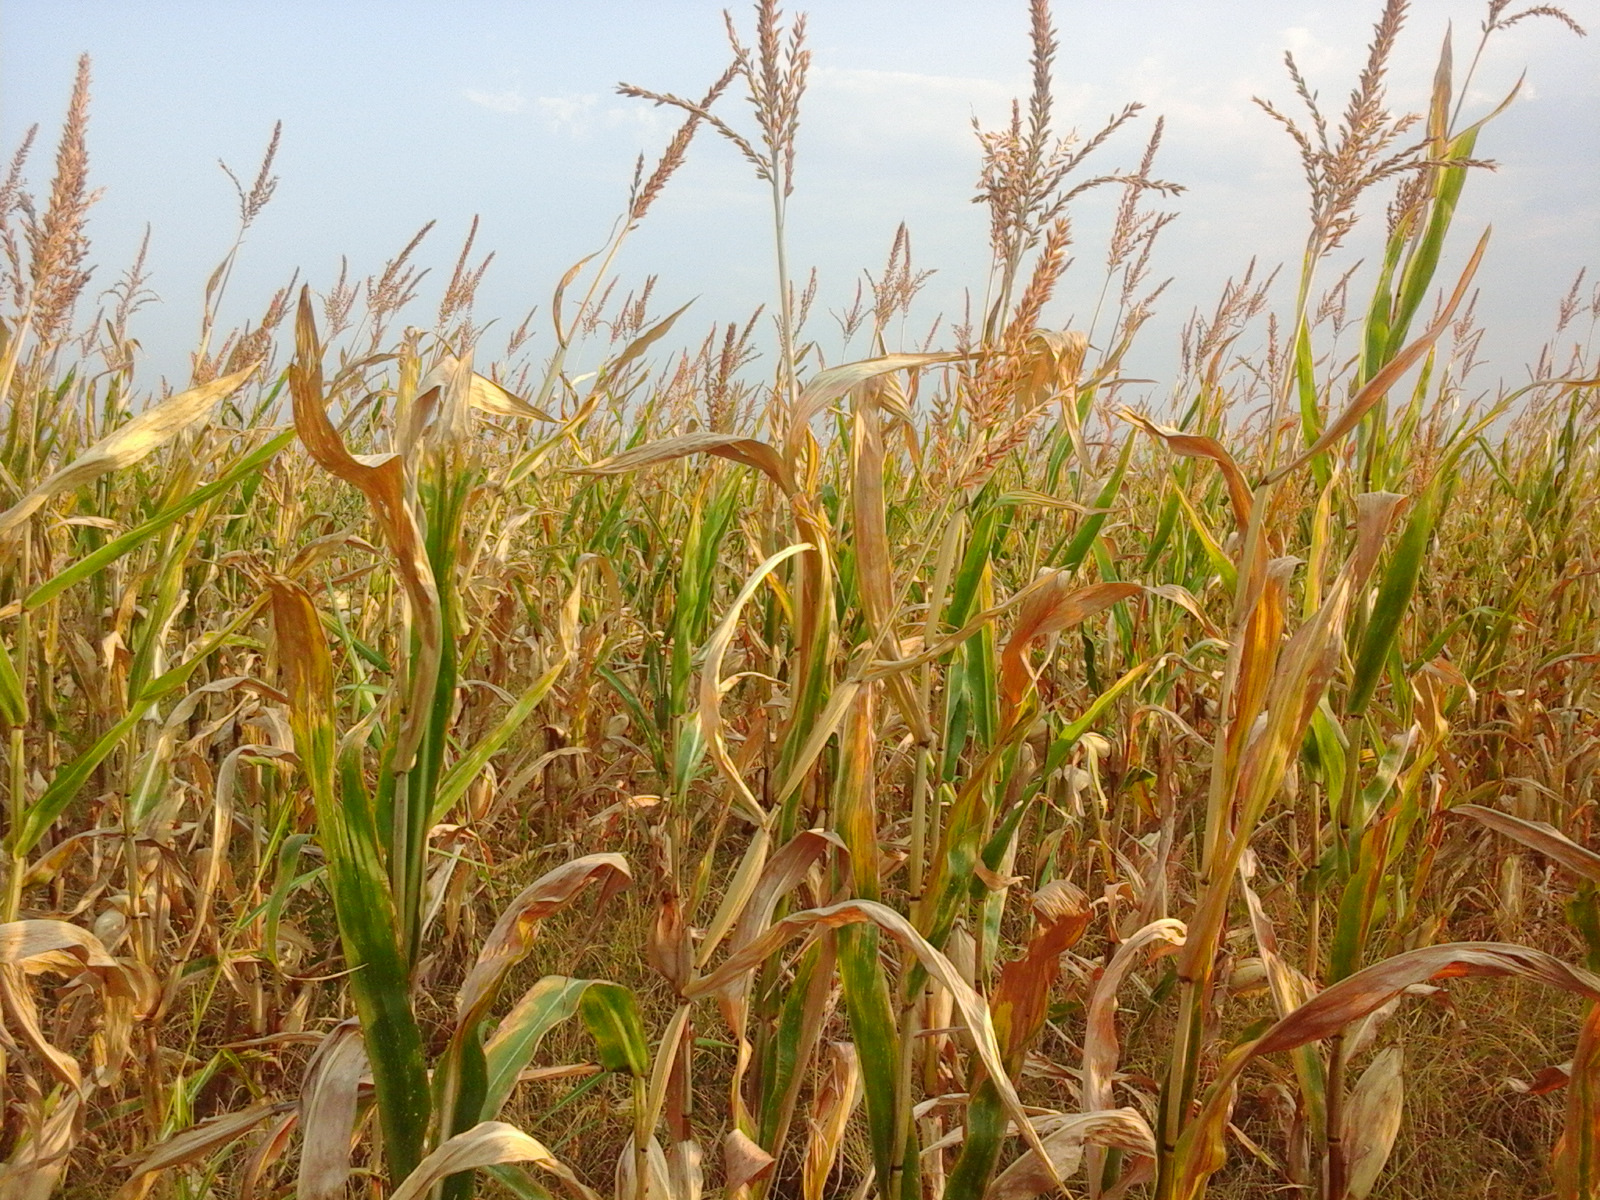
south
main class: Cropland
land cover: Maize
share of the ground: > 75 %
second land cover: Spontaneously vegetated surfaces
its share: > 75 %
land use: Agriculture (excluding fallow land and kitchen gardens)
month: August
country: RO
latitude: 44.0574
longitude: 23.2907
